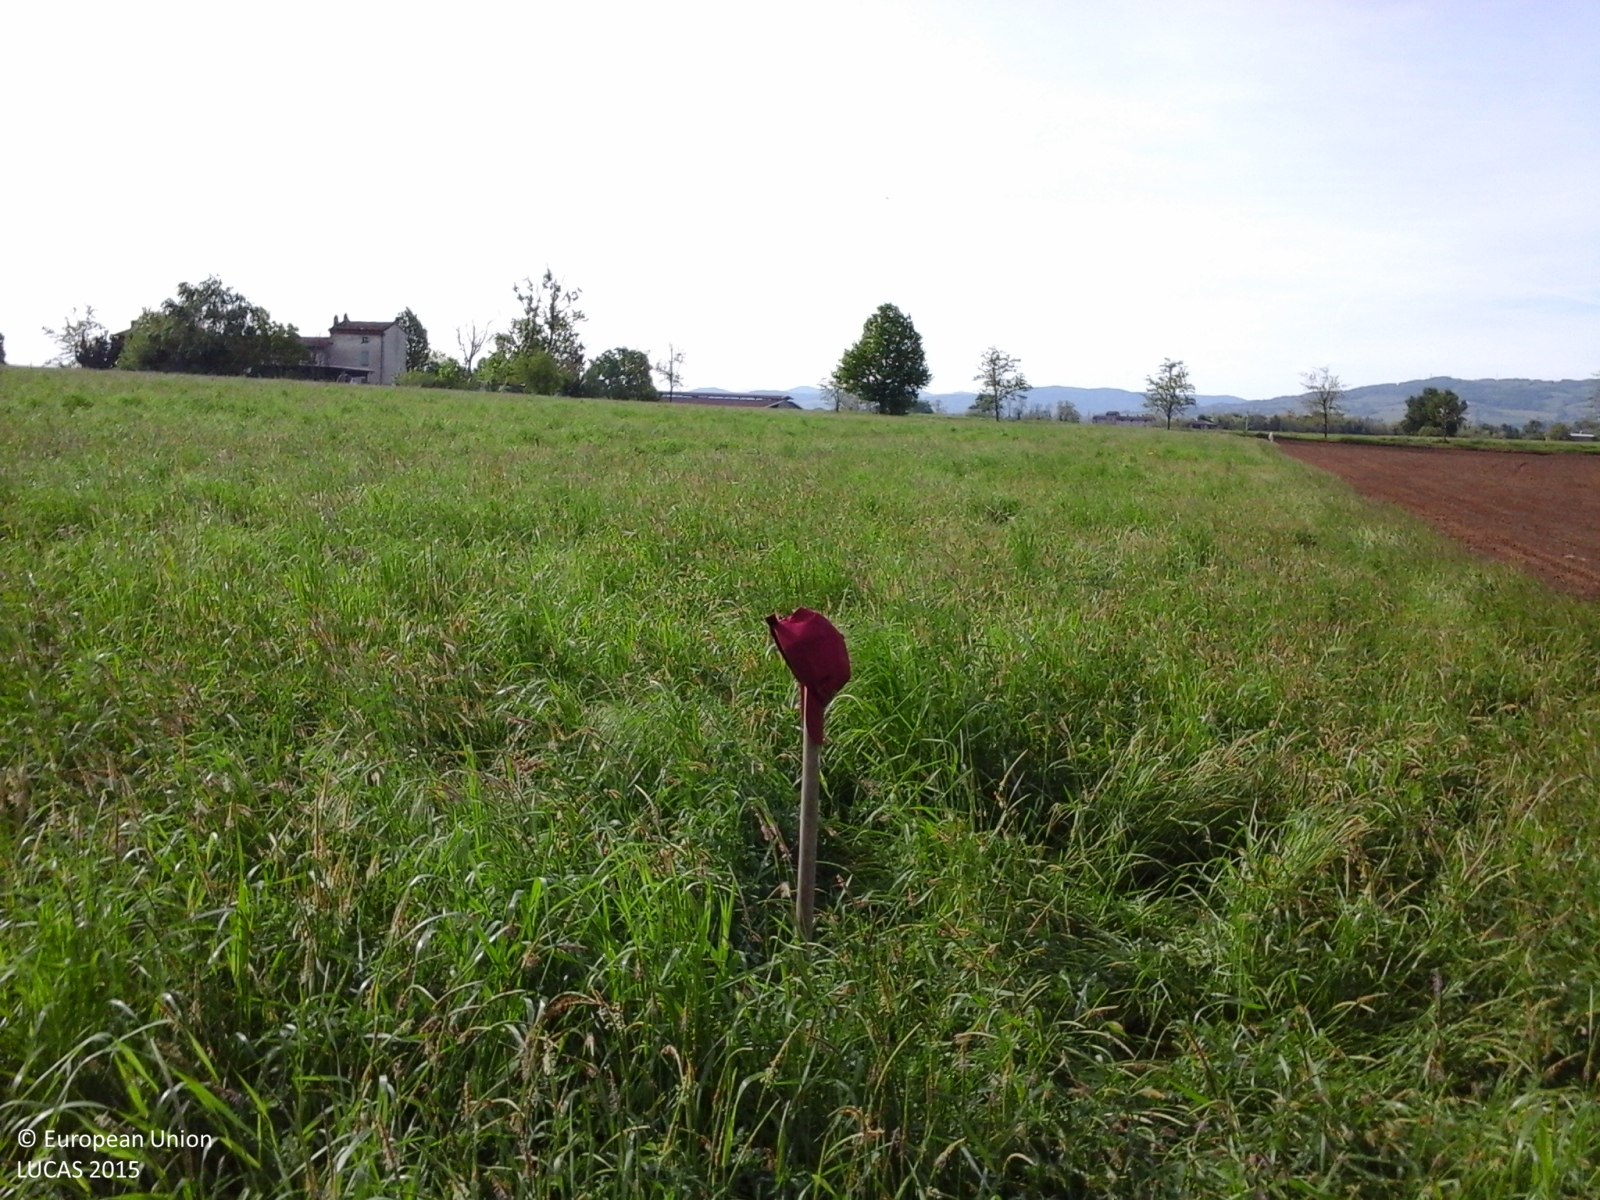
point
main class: Cropland
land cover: Lucerne
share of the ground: > 75 %
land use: Agriculture (excluding fallow land and kitchen gardens)
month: May
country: IT
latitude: 44.9807
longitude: 9.5570
